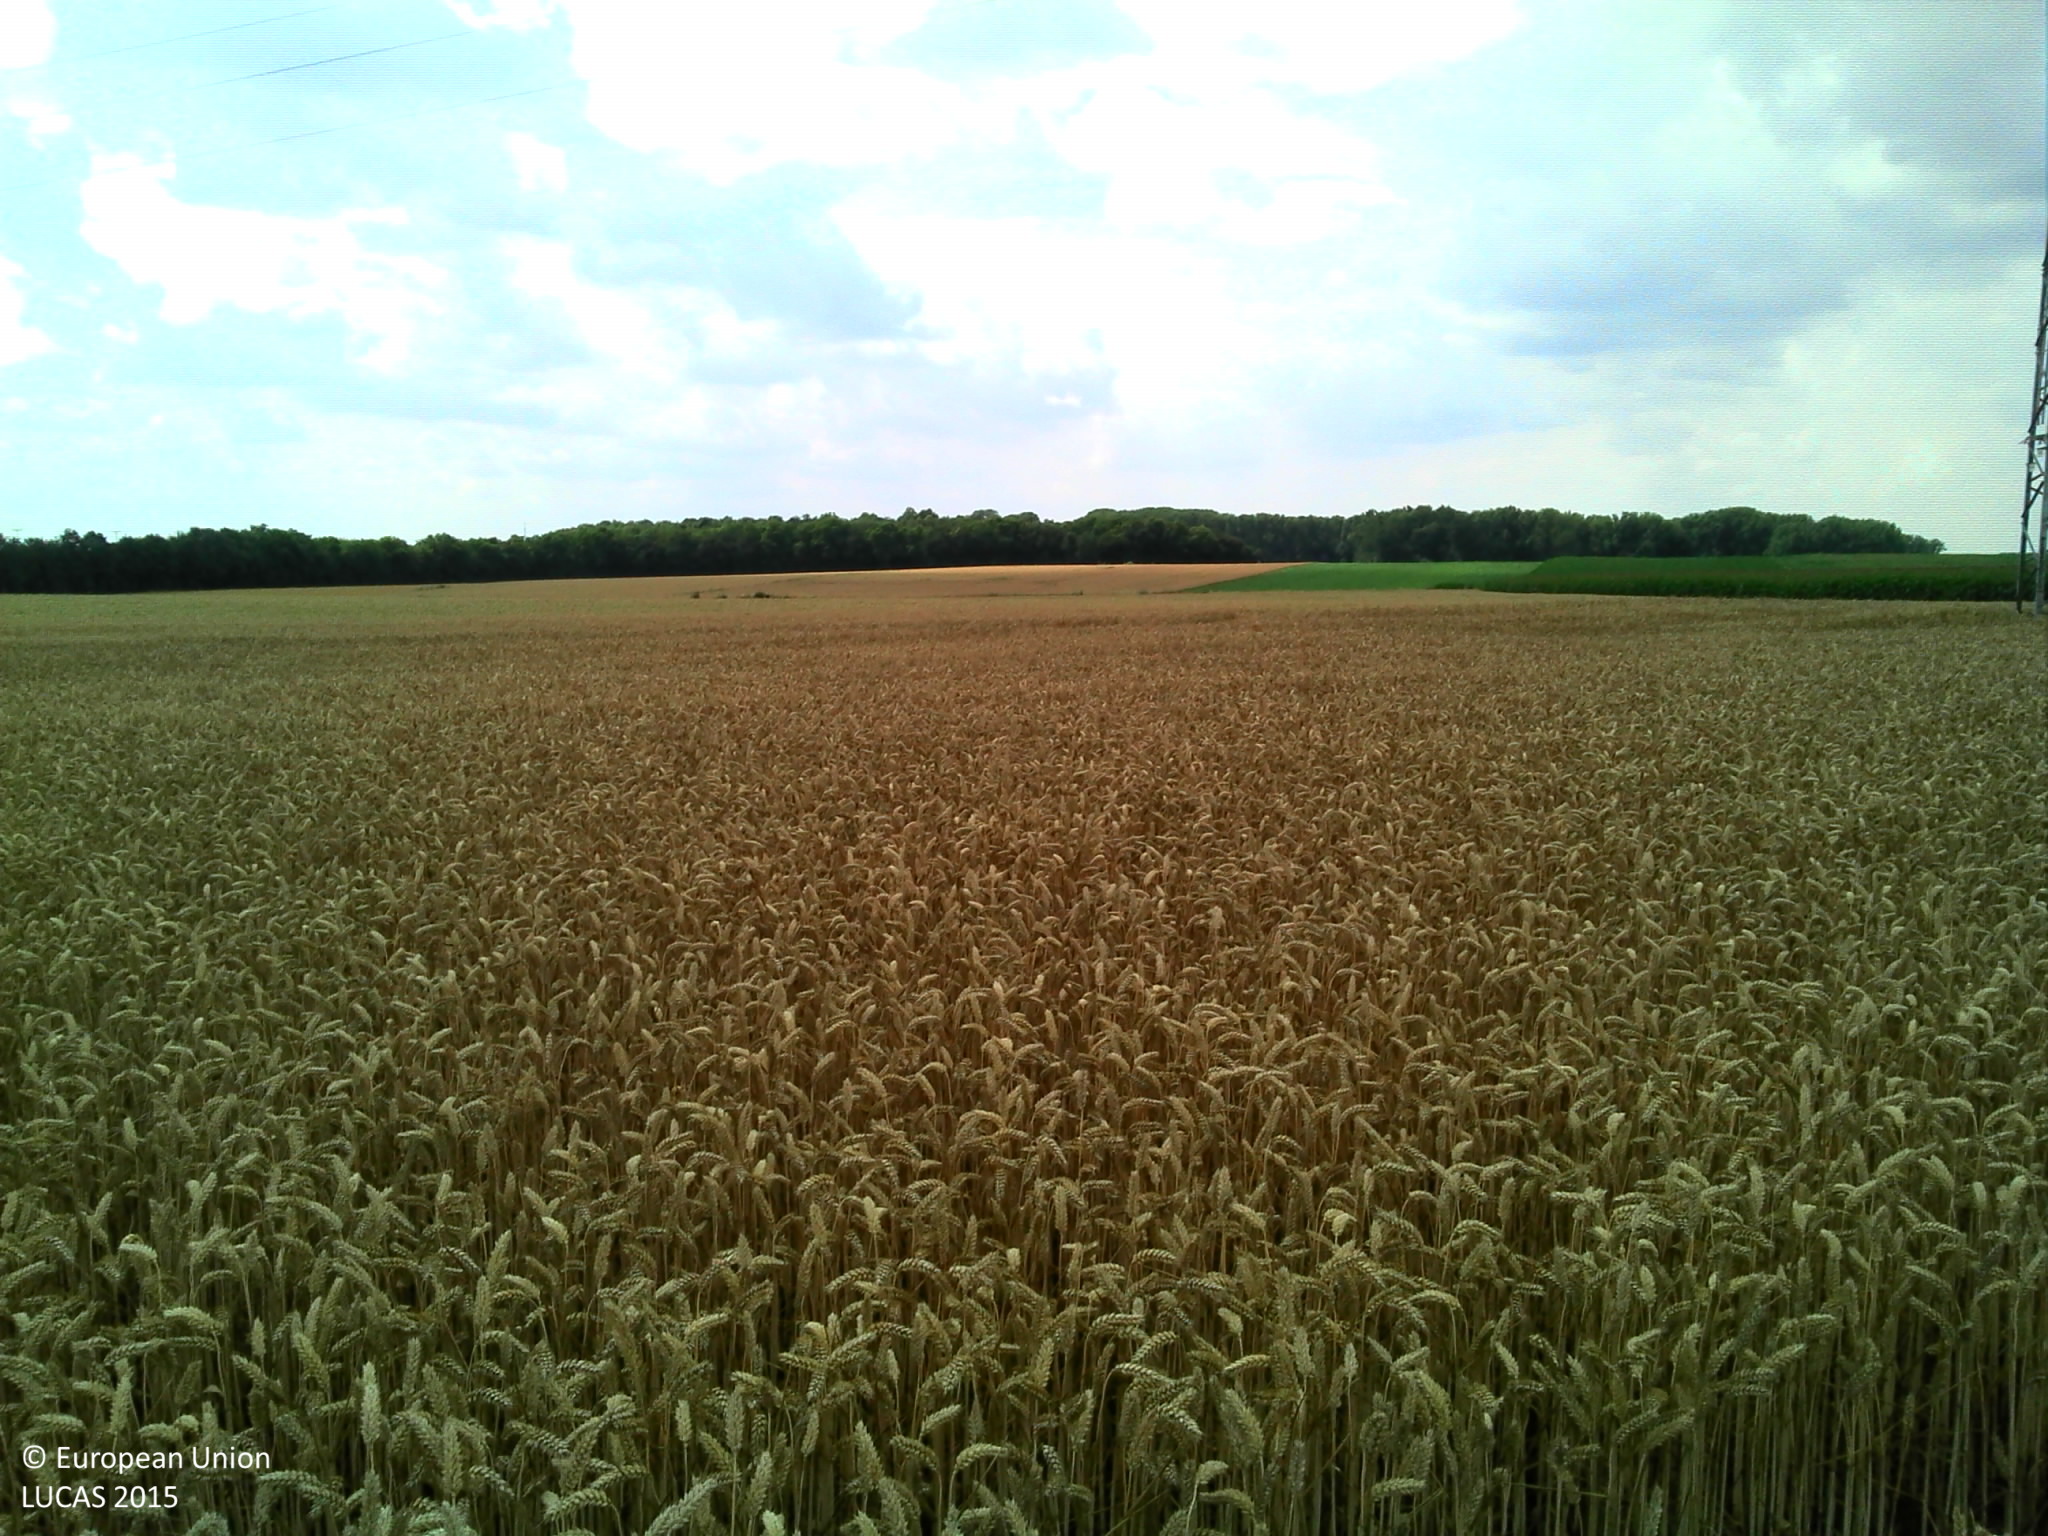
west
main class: Cropland
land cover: Common wheat
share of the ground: > 75 %
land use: Agriculture (excluding fallow land and kitchen gardens)
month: July
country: BE
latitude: 50.5661
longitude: 4.3340
